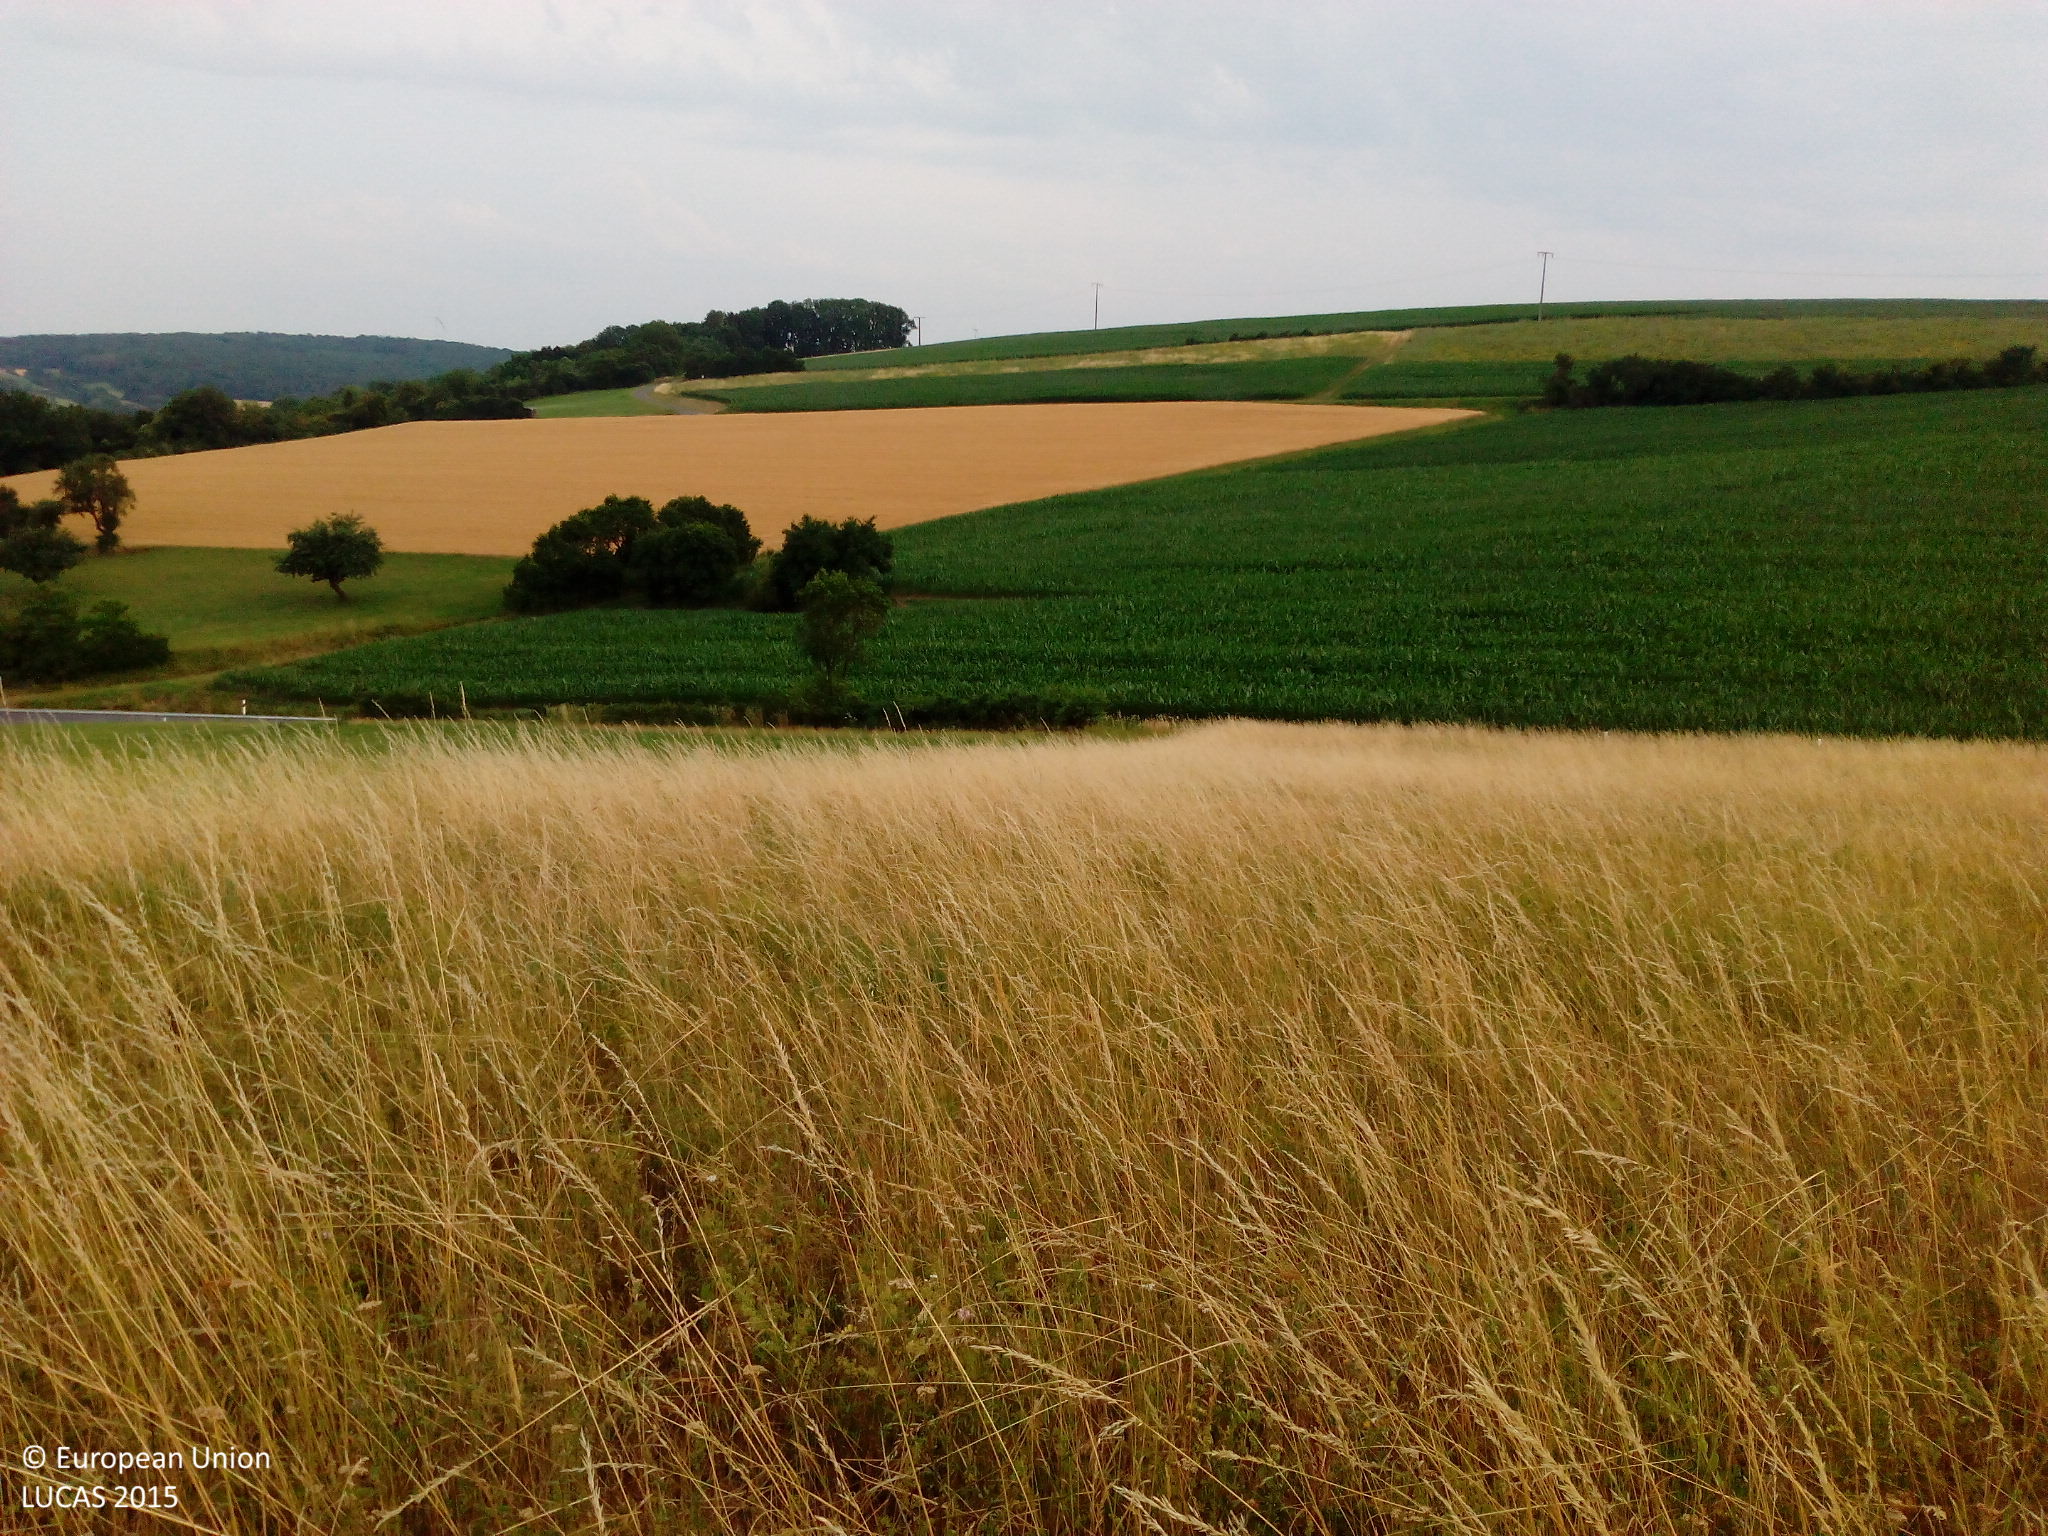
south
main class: Grassland
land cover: Grassland without tree/shrub cover
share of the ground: > 75 %
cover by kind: herbaceous plants 100 %
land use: Agriculture (excluding fallow land and kitchen gardens)
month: July
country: DE
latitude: 49.5188
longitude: 9.9586
